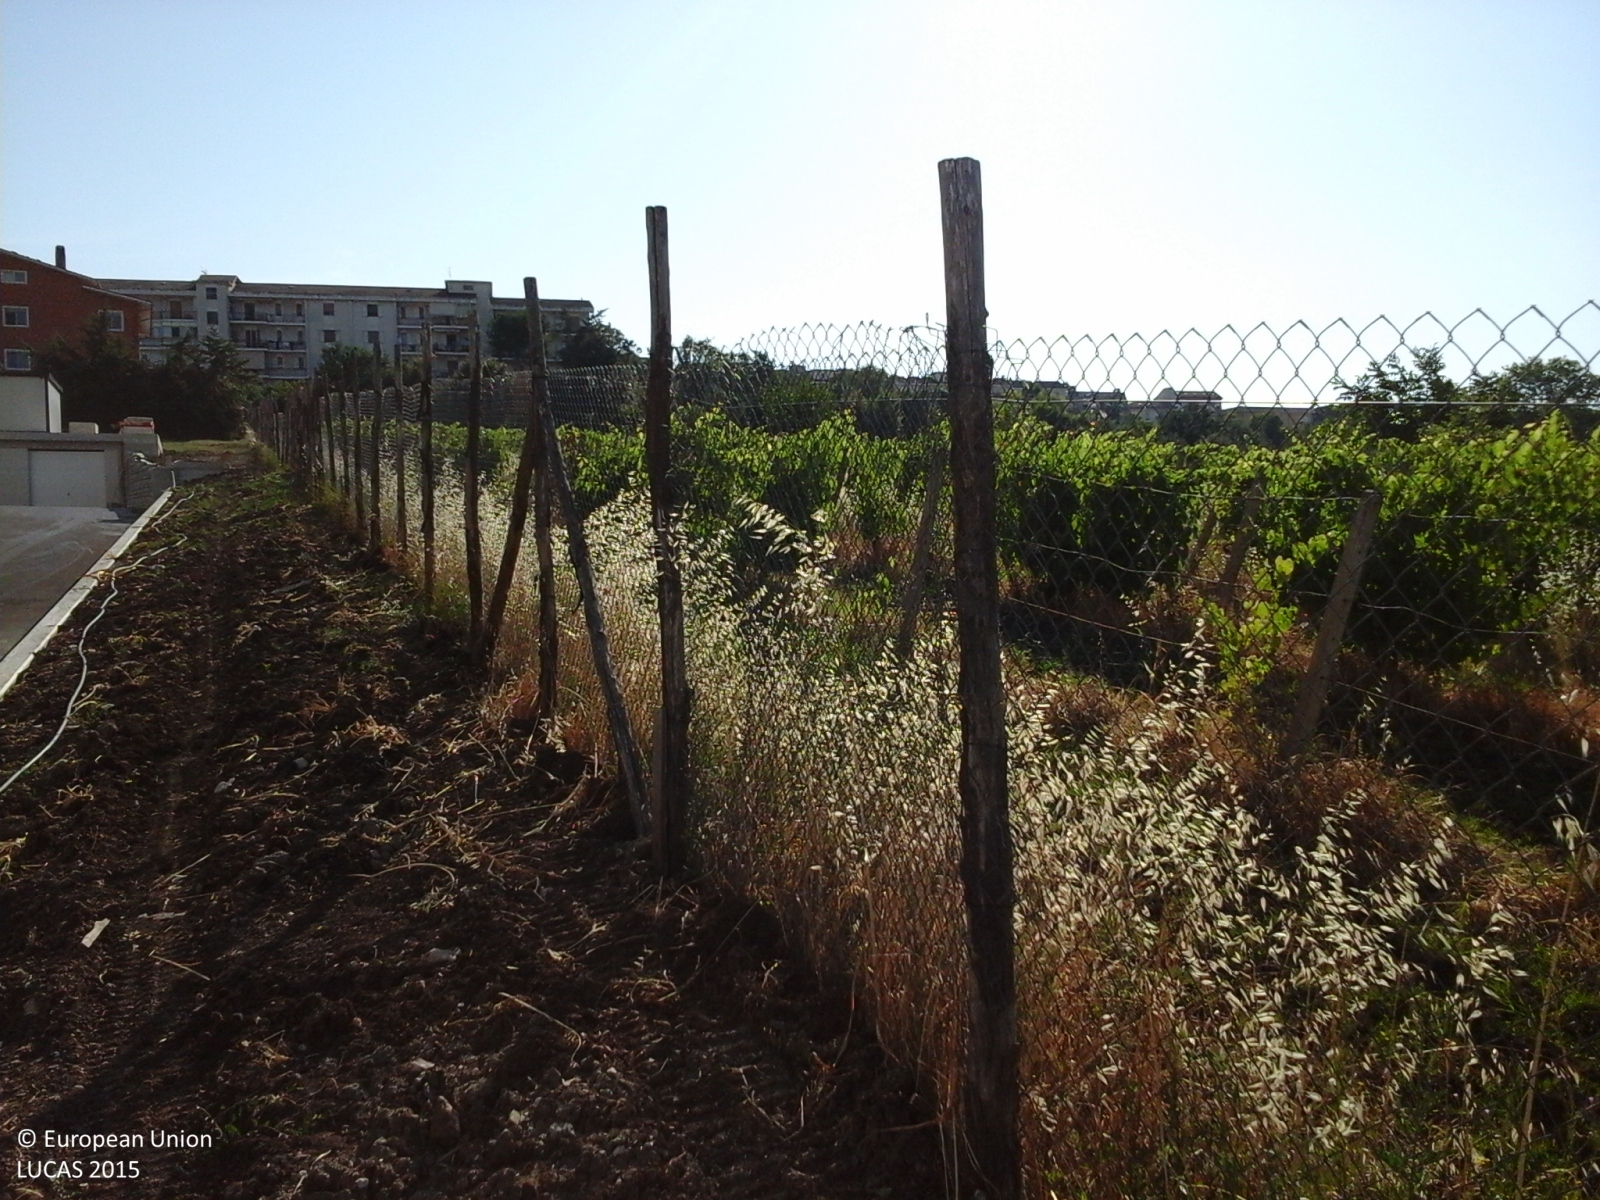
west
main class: Cropland
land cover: Vineyards
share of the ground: 50 - 75 %
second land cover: Spontaneously vegetated surfaces
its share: > 75 %
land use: Agriculture (excluding fallow land and kitchen gardens)
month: July
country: IT
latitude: 41.5510
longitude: 14.6714
